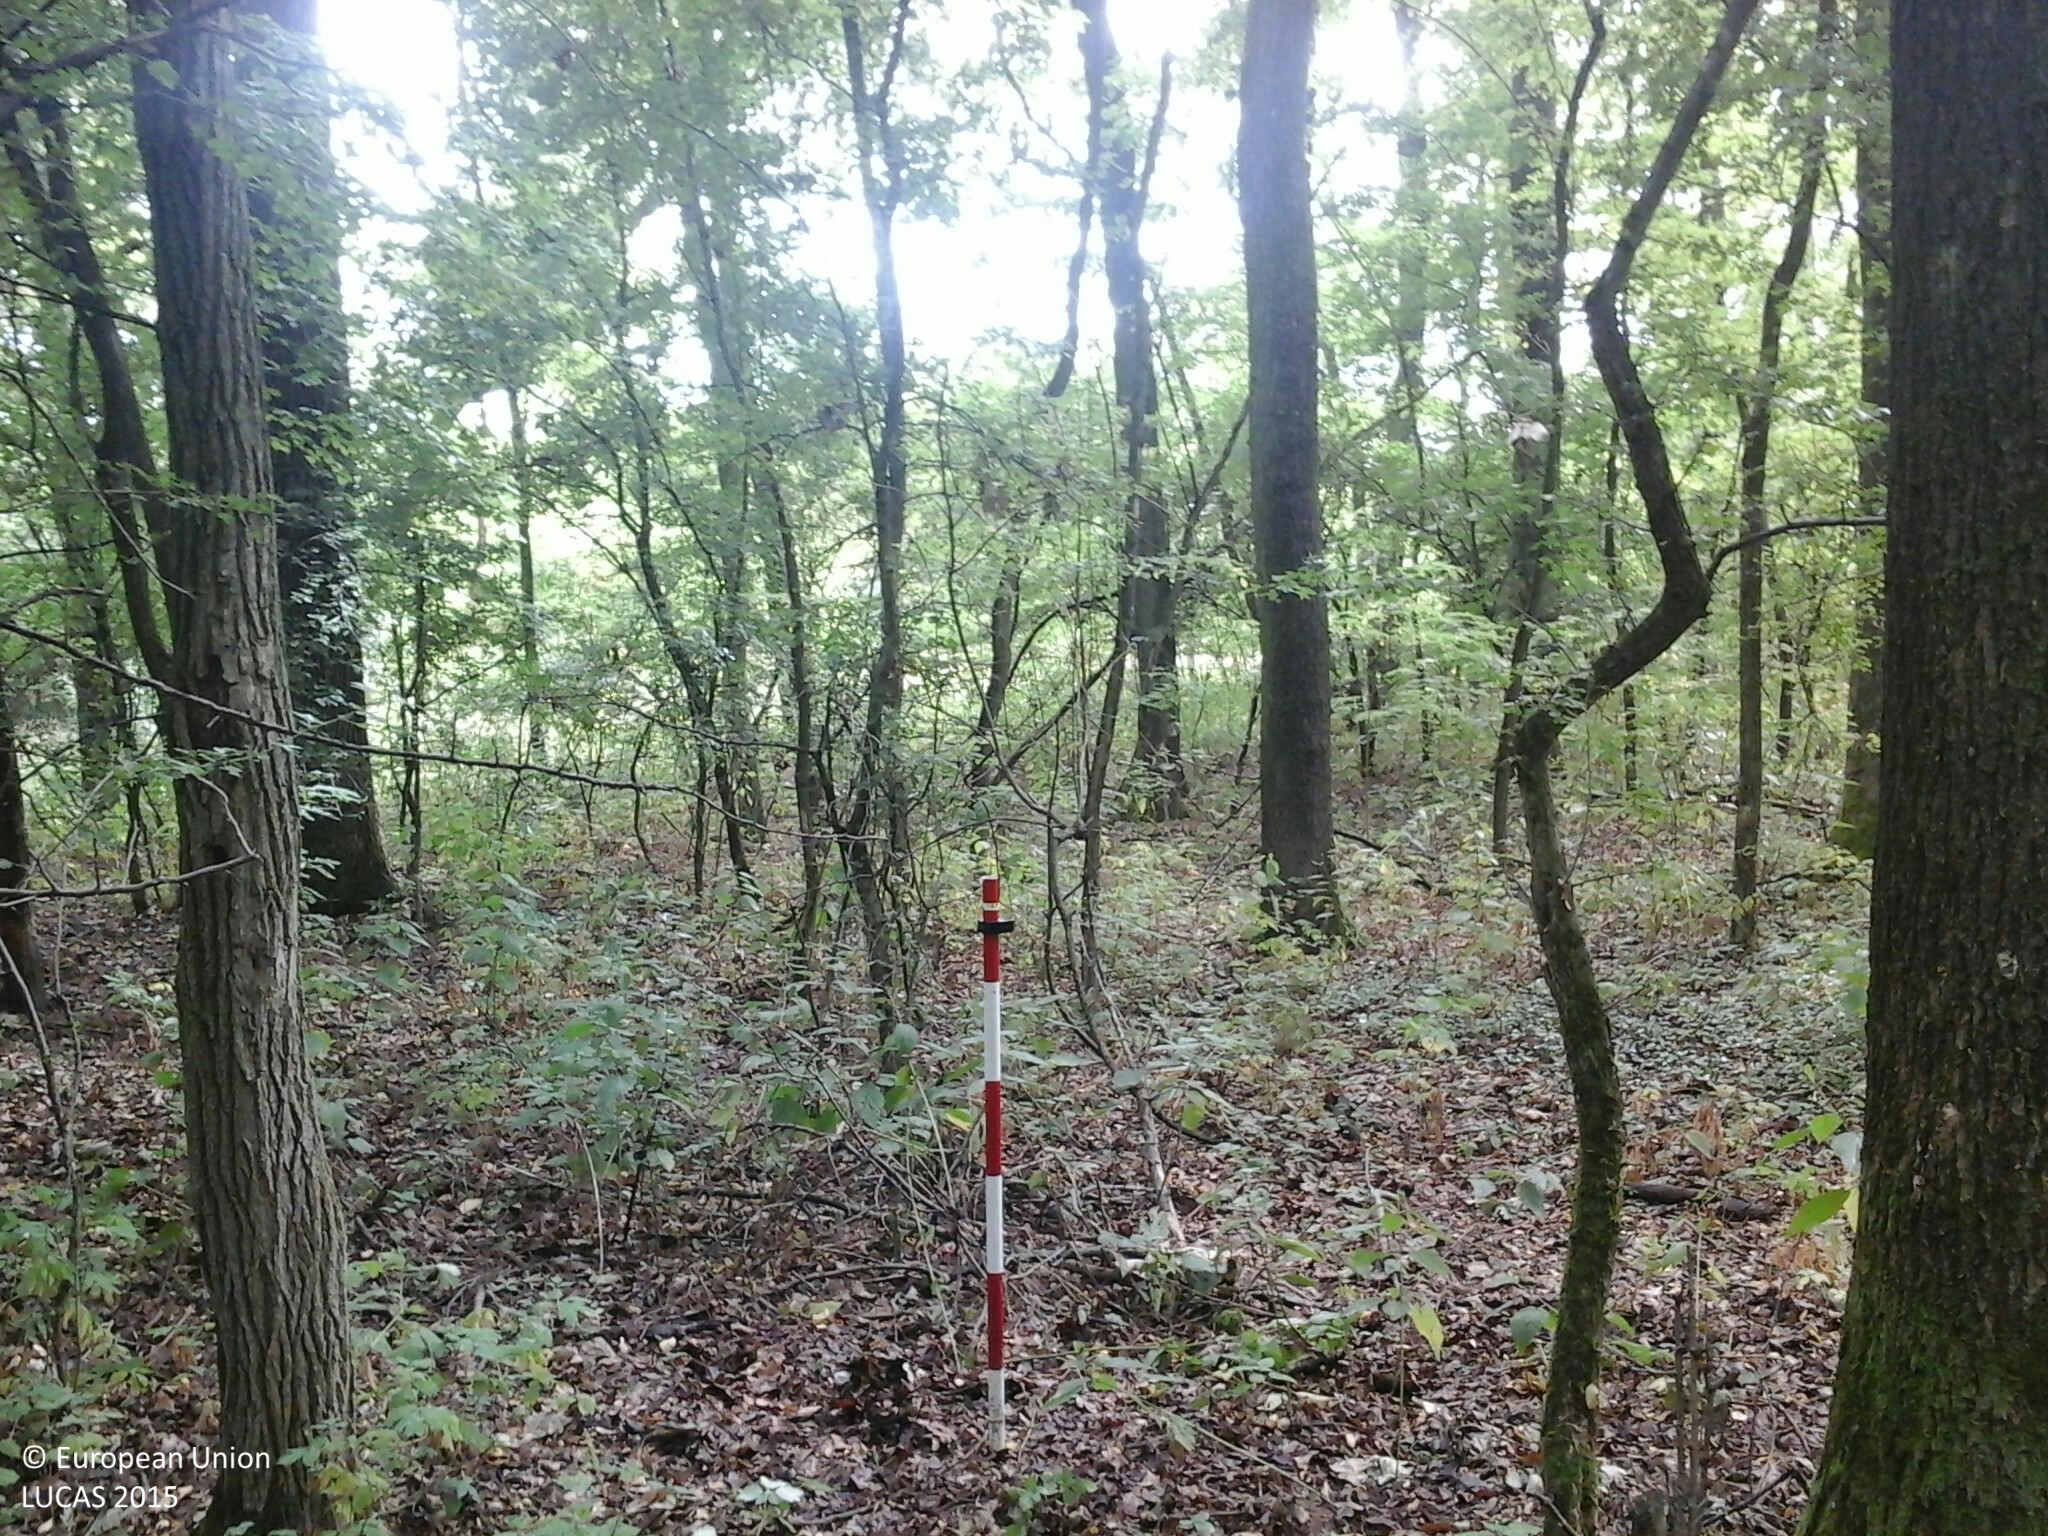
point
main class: Woodland
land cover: Broadleaved woodland
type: mesophytic deciduous forest
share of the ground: > 75 %
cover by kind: broadleaved forest trees 95 %, herbaceous plants 5 %
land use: Forestry
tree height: > 5 m
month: July
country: HU
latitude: 47.9199
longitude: 22.0832
